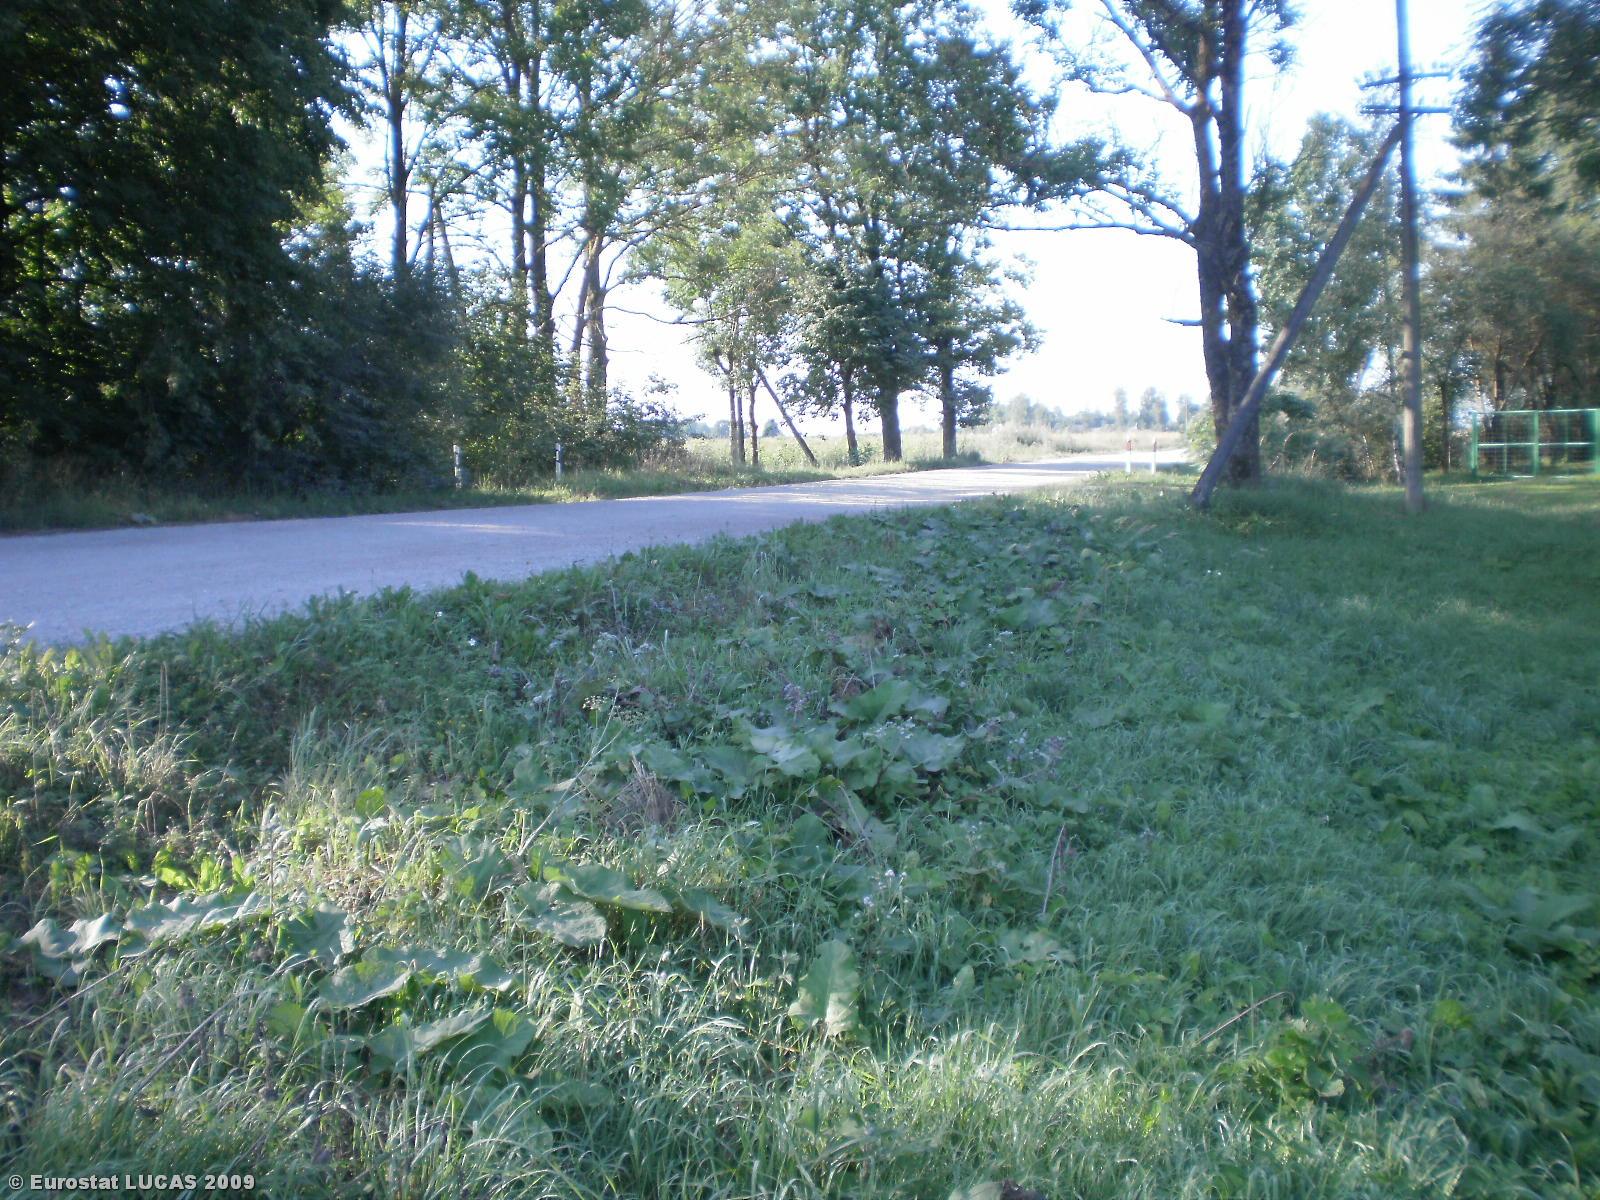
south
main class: Grassland
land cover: Grassland with sparse tree/shrub cover
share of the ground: > 75 %
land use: Residential
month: August
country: LT
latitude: 55.5243
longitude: 24.9531
